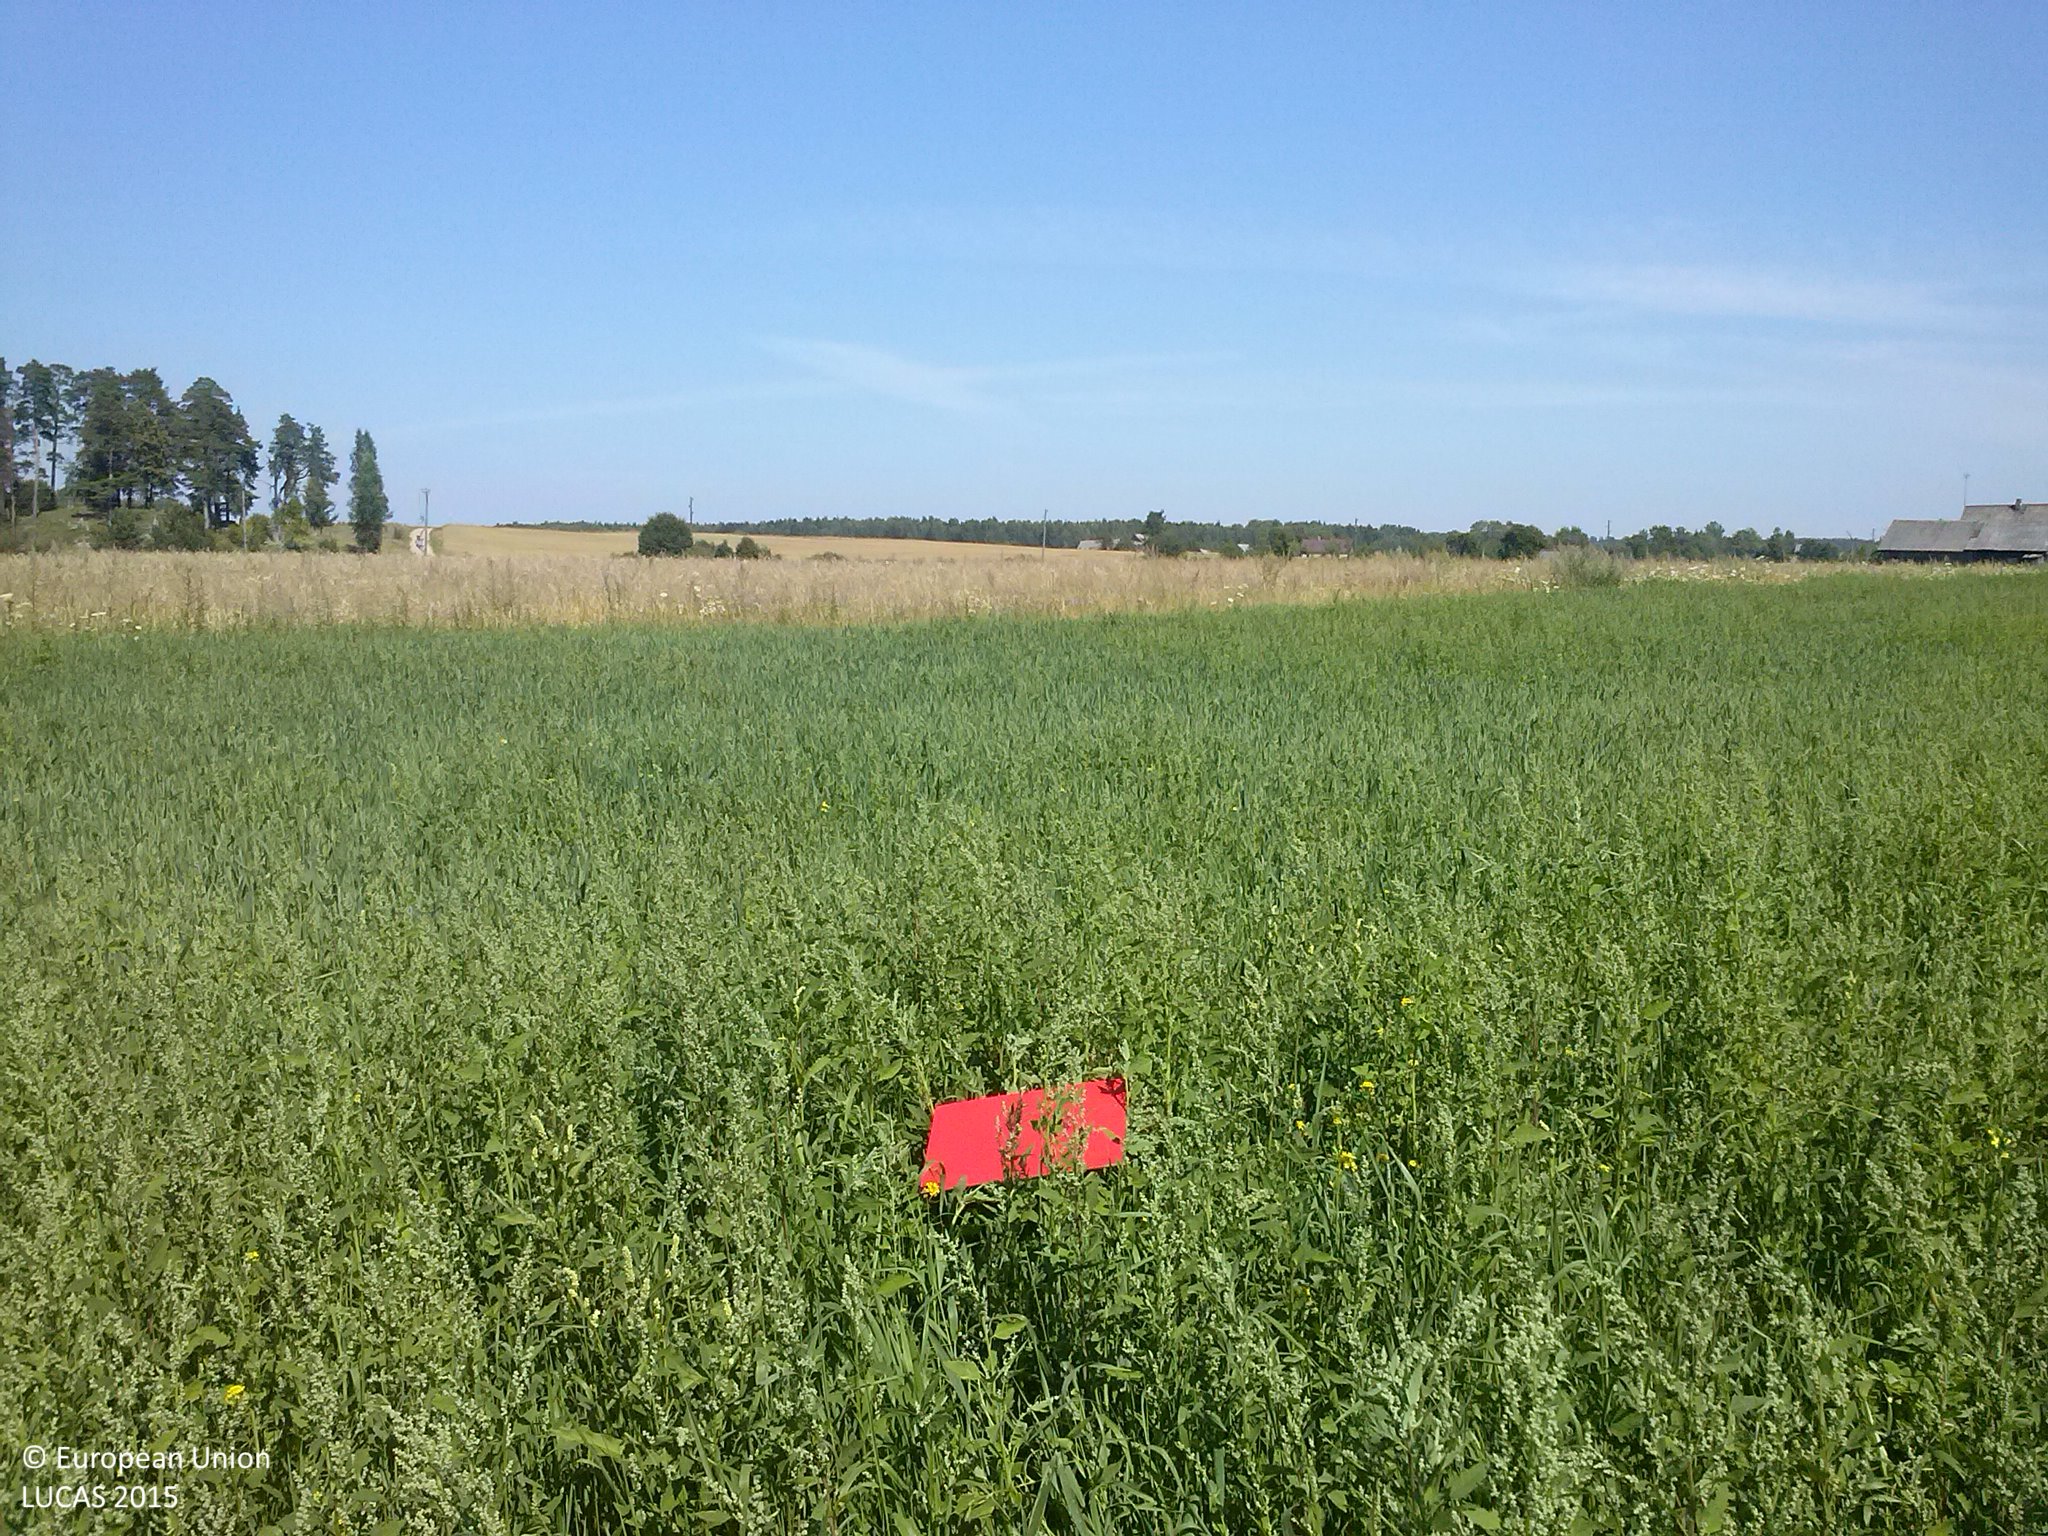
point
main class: Grassland
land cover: Grassland without tree/shrub cover
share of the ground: > 75 %
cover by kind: herbaceous plants 100 %
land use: Agriculture (excluding fallow land and kitchen gardens)
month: August
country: LV
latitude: 56.7344
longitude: 27.8270
